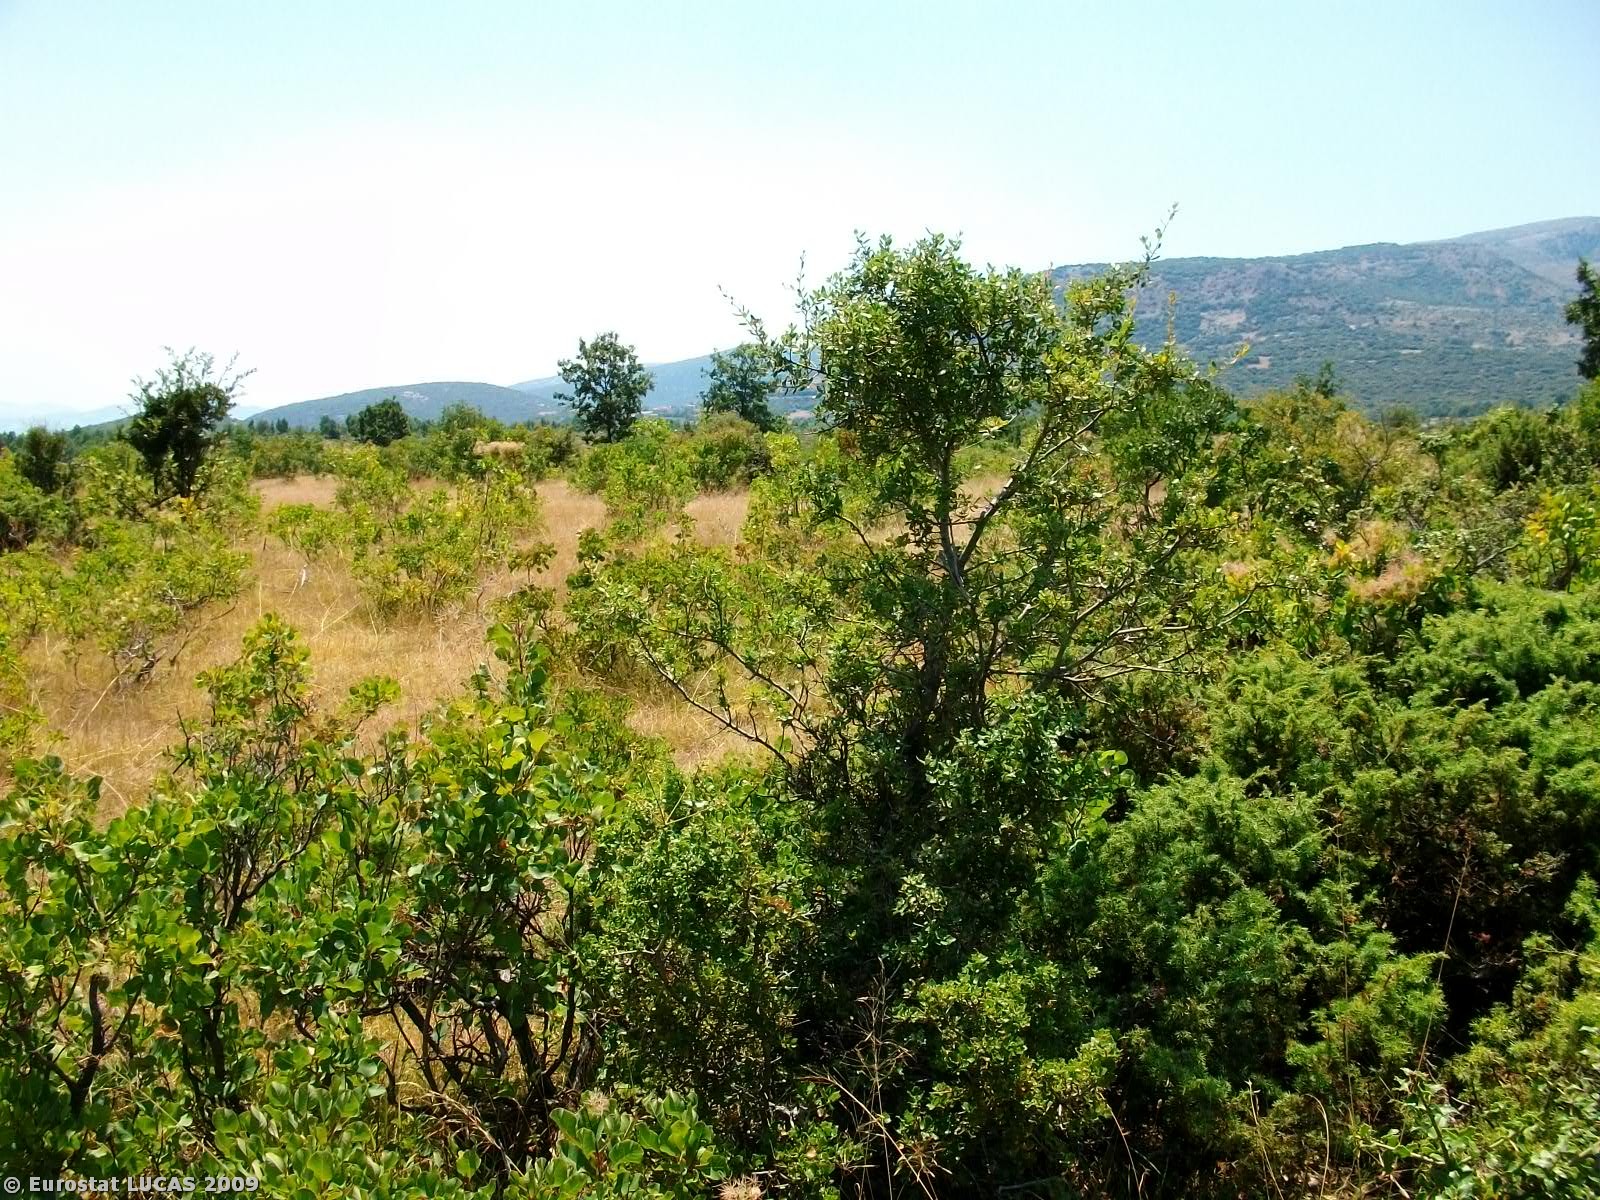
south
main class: Shrubland
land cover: Shrubland with sparse tree cover
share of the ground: 50 - 75 %
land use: Unused
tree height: > 5 m
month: July
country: GR
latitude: 40.1951
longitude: 21.7726
